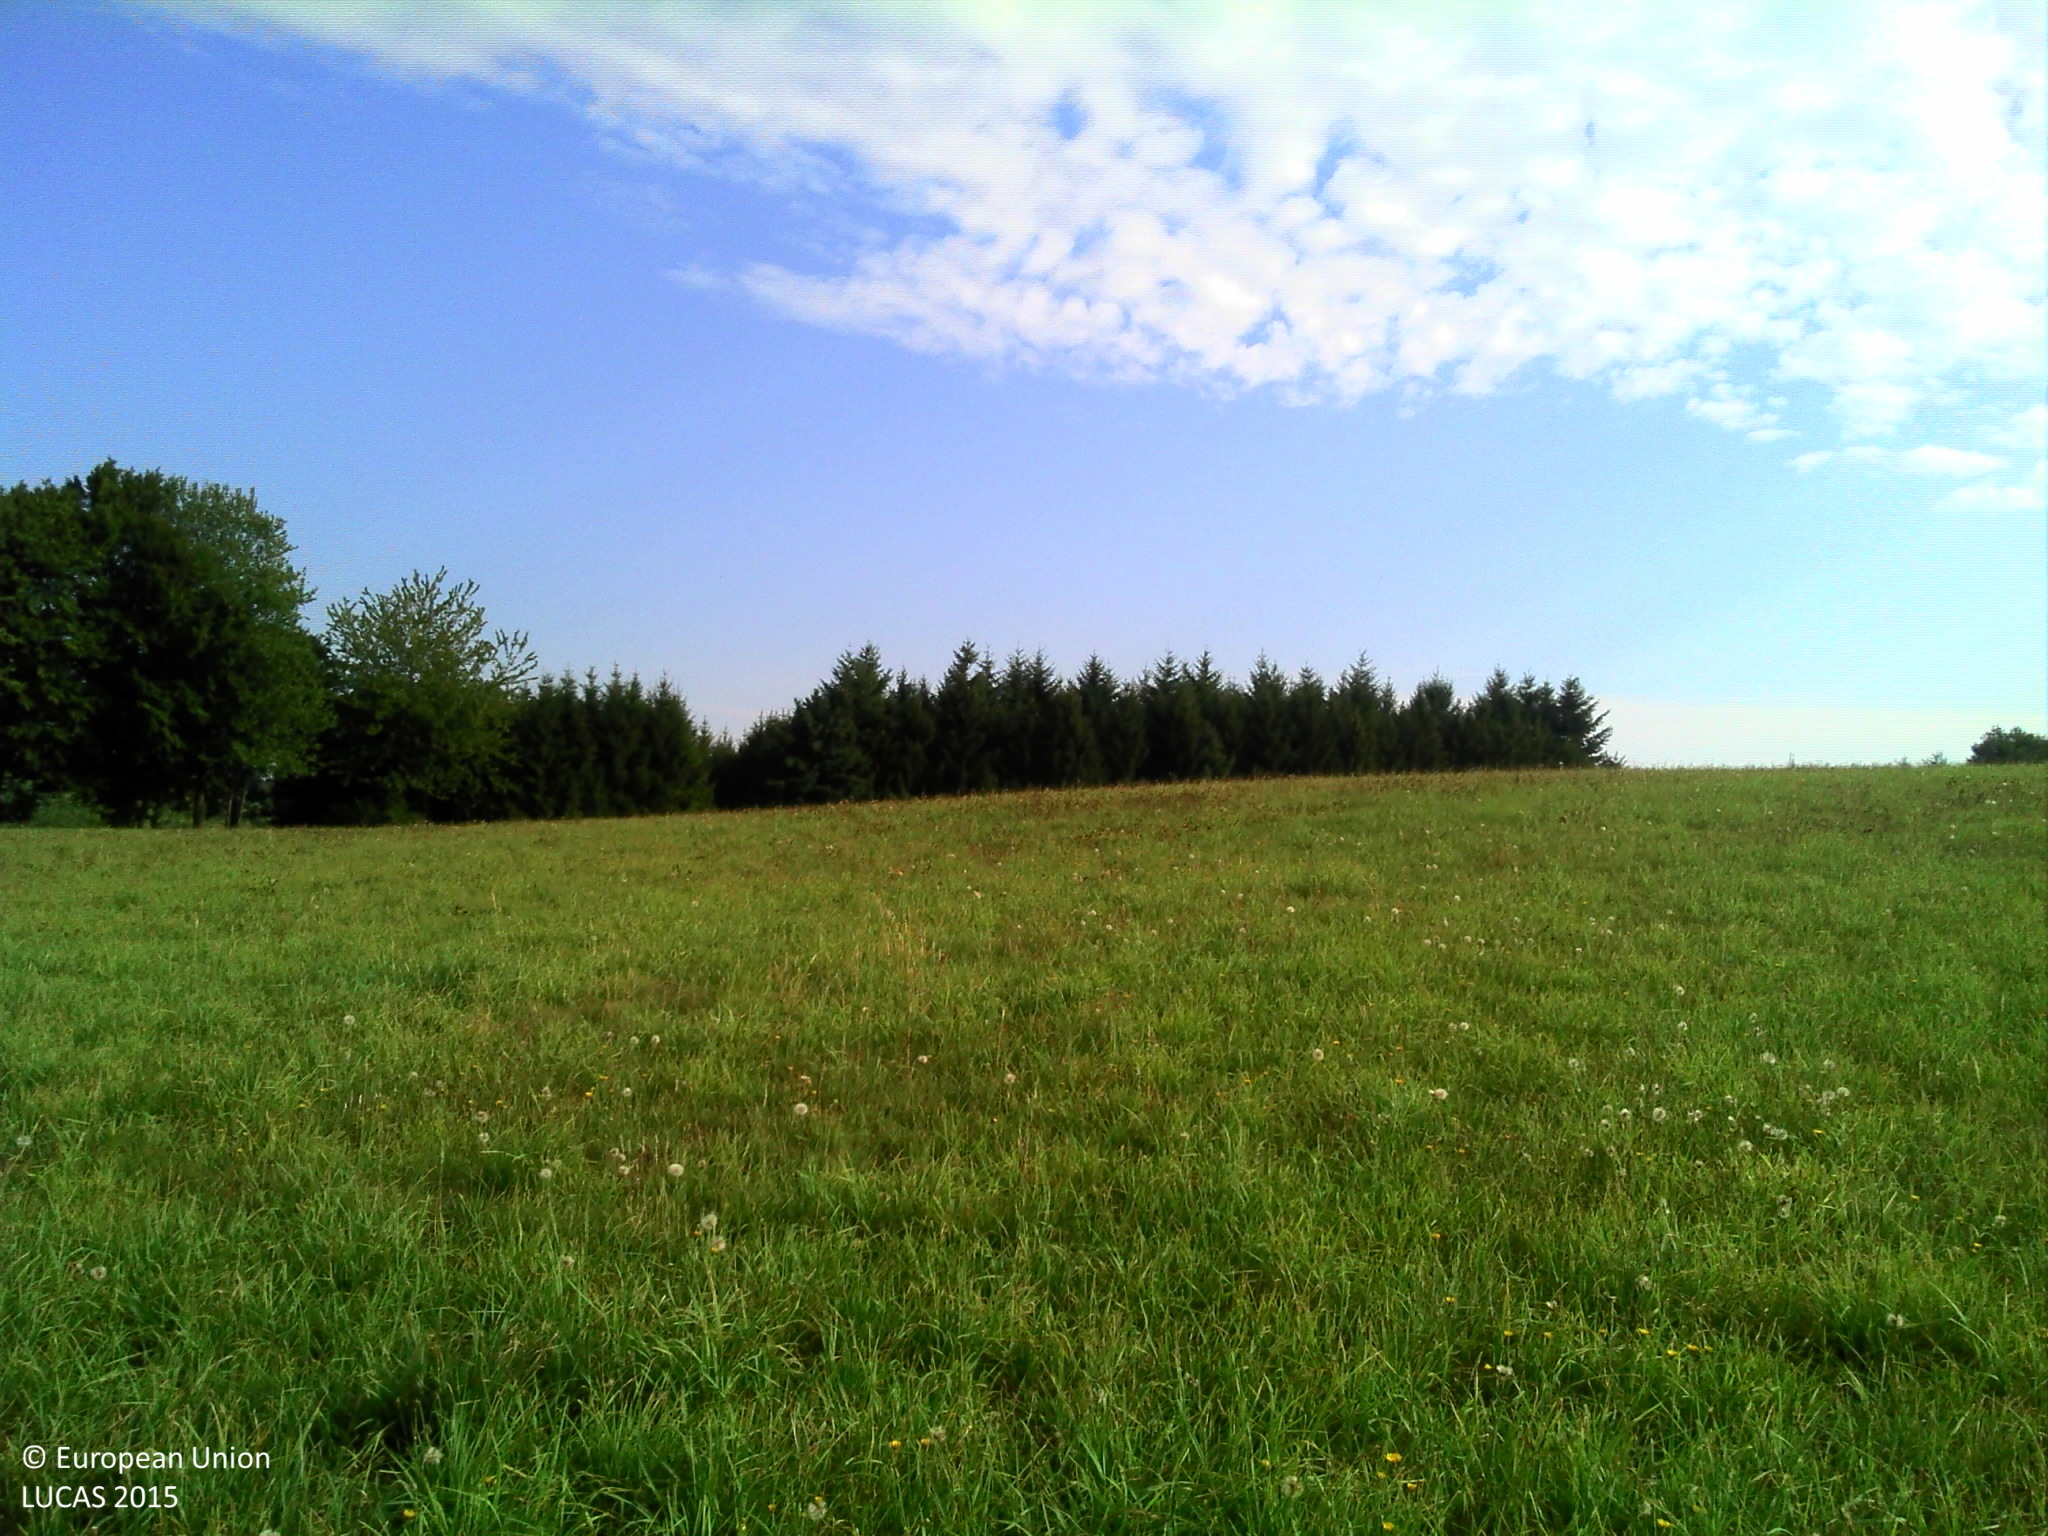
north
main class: Grassland
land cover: Grassland without tree/shrub cover
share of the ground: > 75 %
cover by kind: herbaceous plants 100 %
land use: Agriculture (excluding fallow land and kitchen gardens)
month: August
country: FR
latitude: 48.9468
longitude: 7.3107
